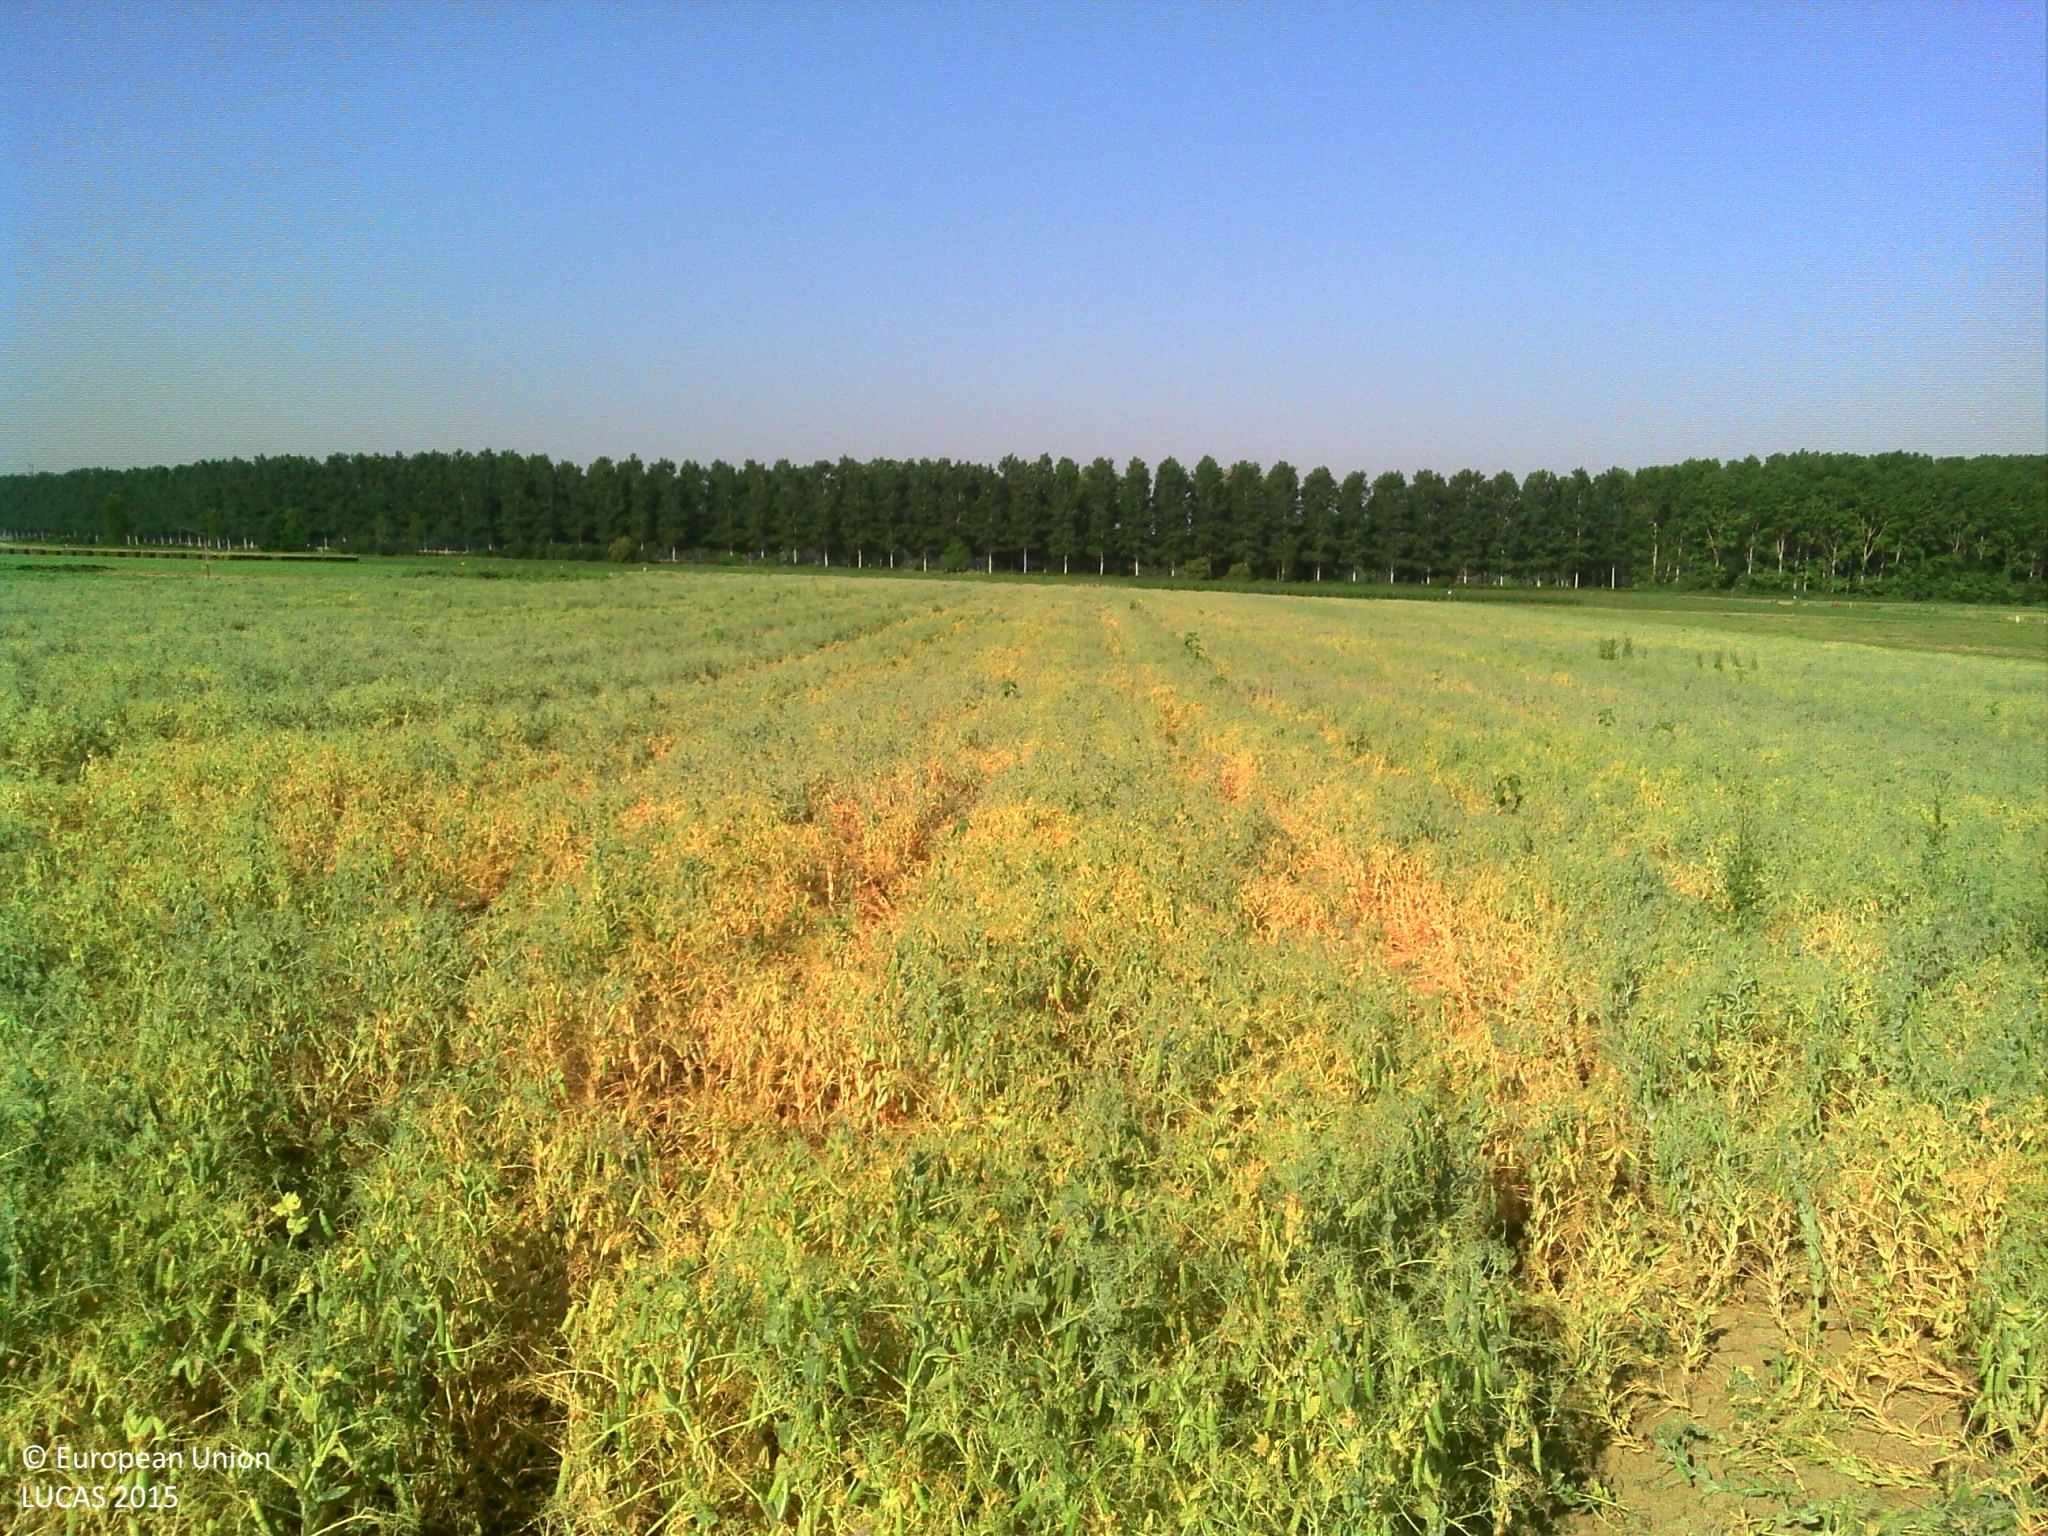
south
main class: Cropland
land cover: Dry pulses
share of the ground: > 75 %
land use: Agriculture (excluding fallow land and kitchen gardens)
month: June
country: FR
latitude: 43.8022
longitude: 1.2876
